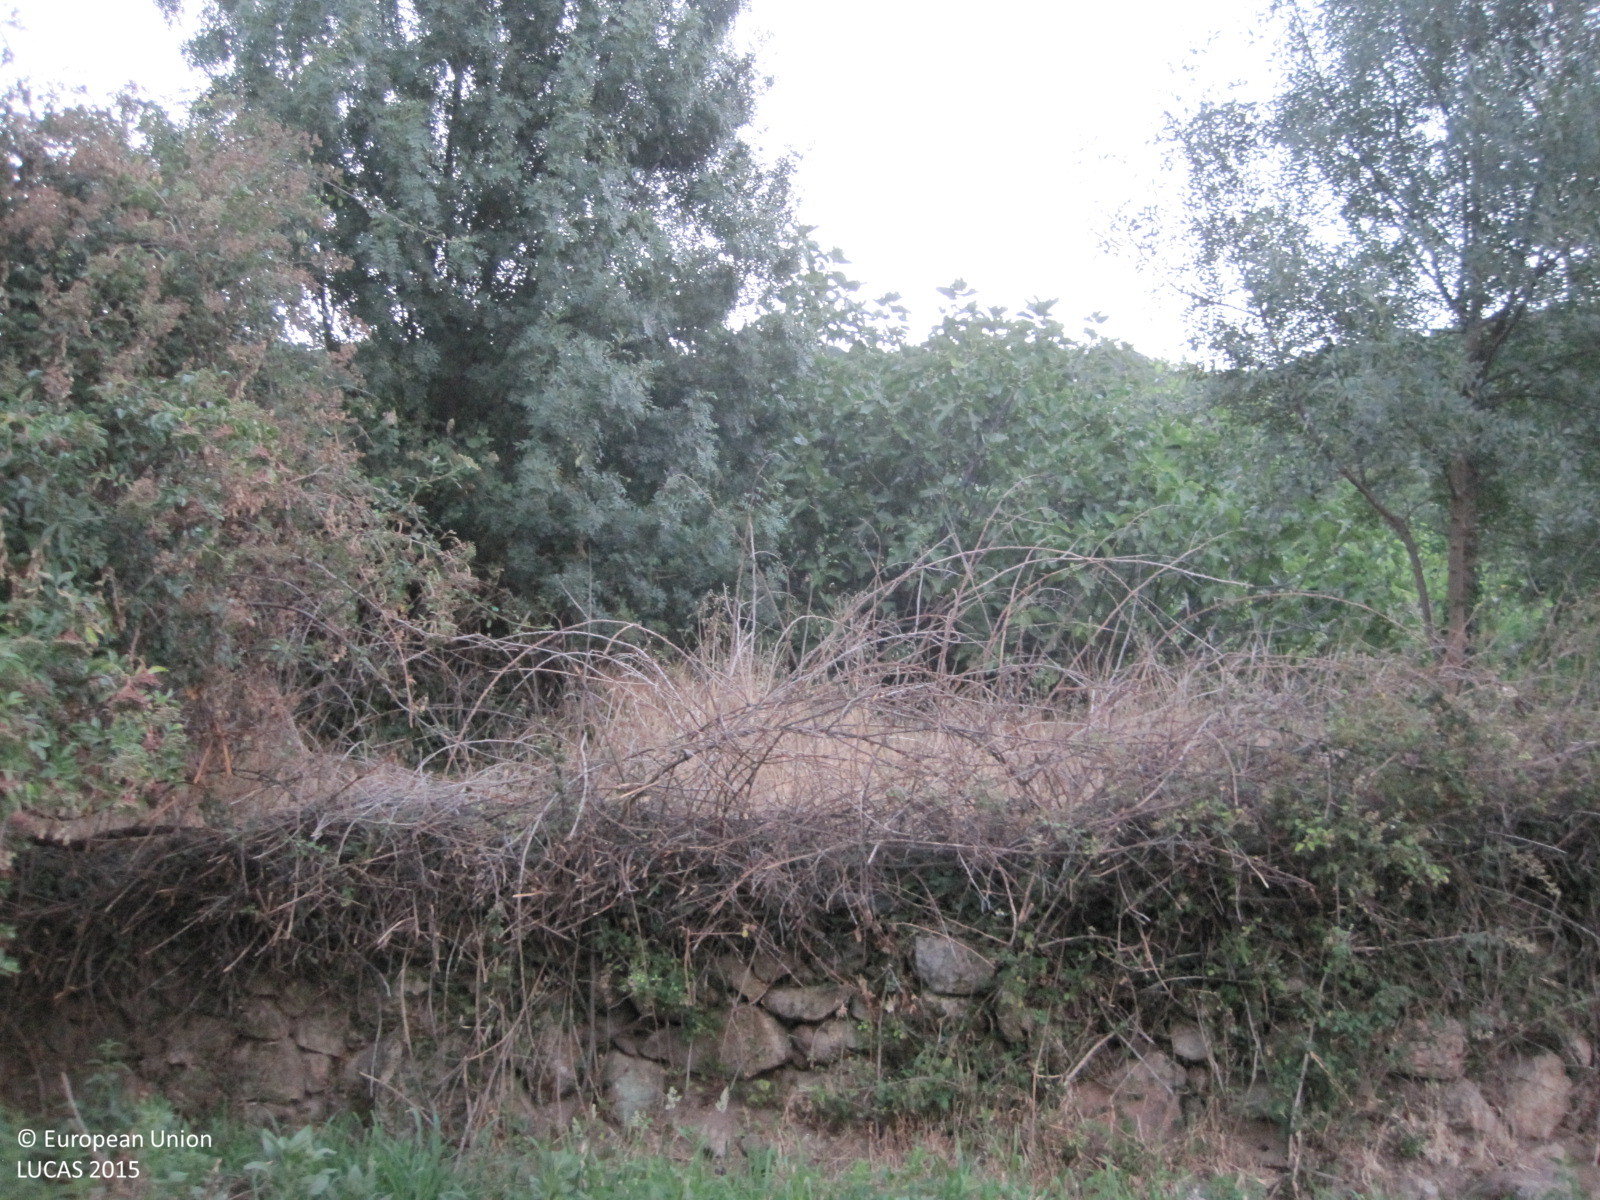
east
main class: Grassland
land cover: Grassland with sparse tree/shrub cover
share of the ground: > 75 %
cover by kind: herbaceous plants 95 %, broadleaved forest trees 5 %
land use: Agriculture (excluding fallow land and kitchen gardens)
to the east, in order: Grassland with sparse tree/shrub cover; Dry stone walls; Other fruit trees and berries; Fences; Dry stone walls; Shrubland with sparse tree cover; Dry stone walls; Grassland with sparse tree/shrub cover; Fences; Tracks; Fences; Shrubland with sparse tree cover; Grassland without tree/shrub cover; Shrubland with sparse tree cover; Artificial constructions in urban areas
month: July
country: ES
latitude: 40.2885
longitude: -4.8386
